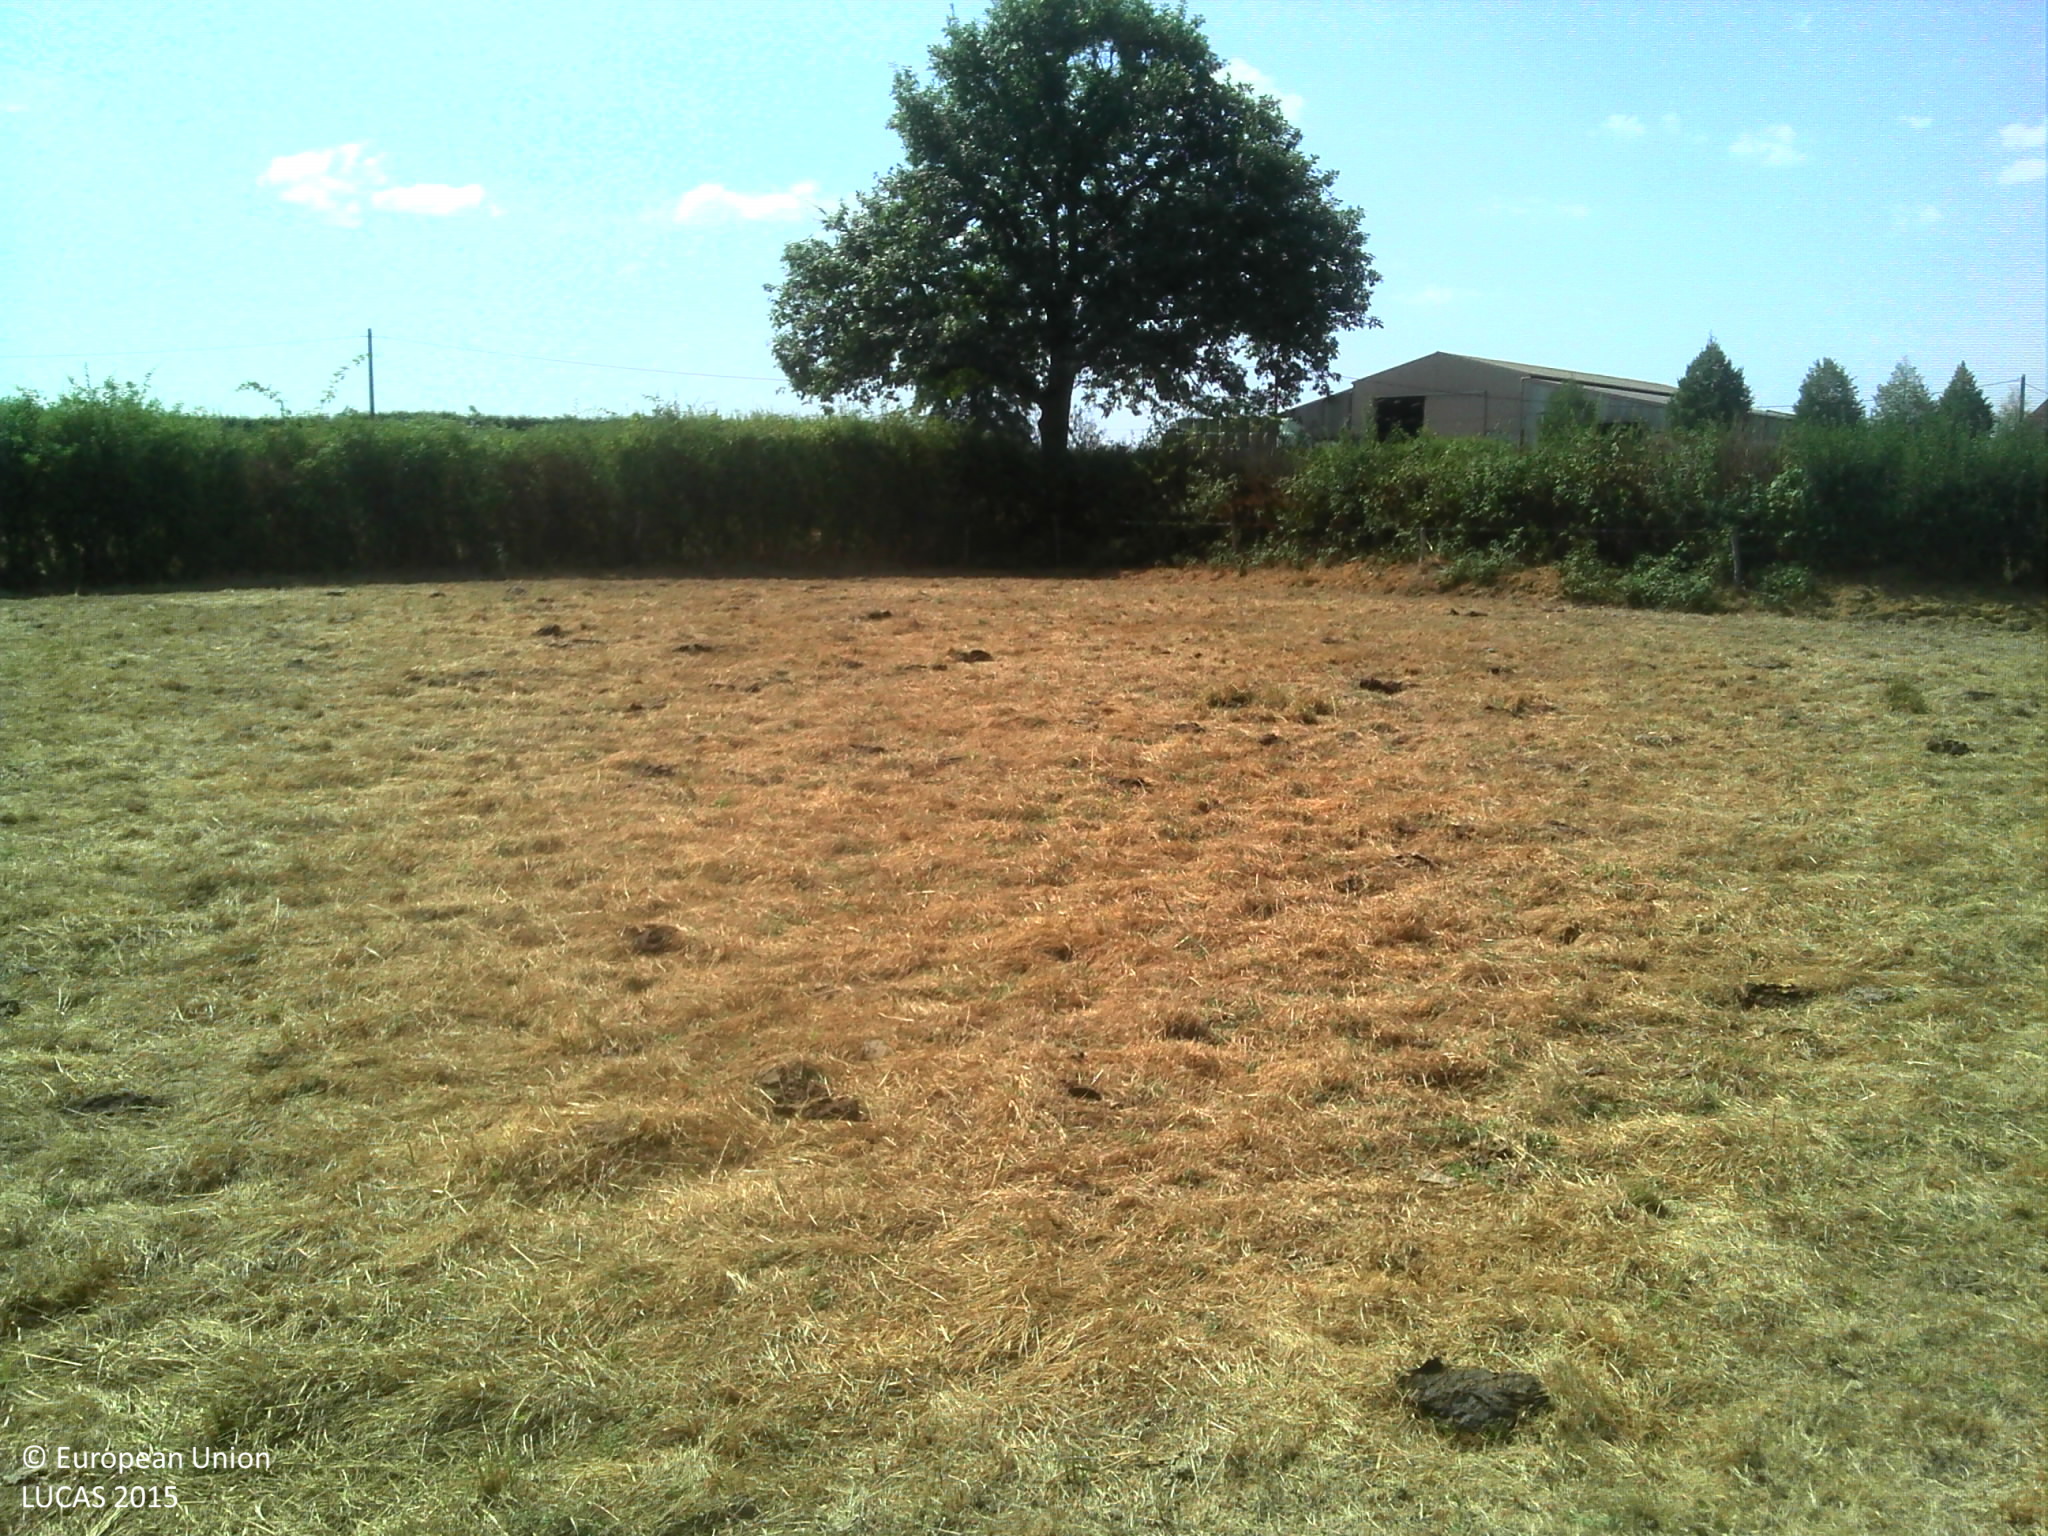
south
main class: Grassland
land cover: Grassland without tree/shrub cover
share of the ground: > 75 %
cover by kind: herbaceous plants 100 %
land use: Agriculture (excluding fallow land and kitchen gardens)
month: August
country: FR
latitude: 46.7453
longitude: 4.3853
